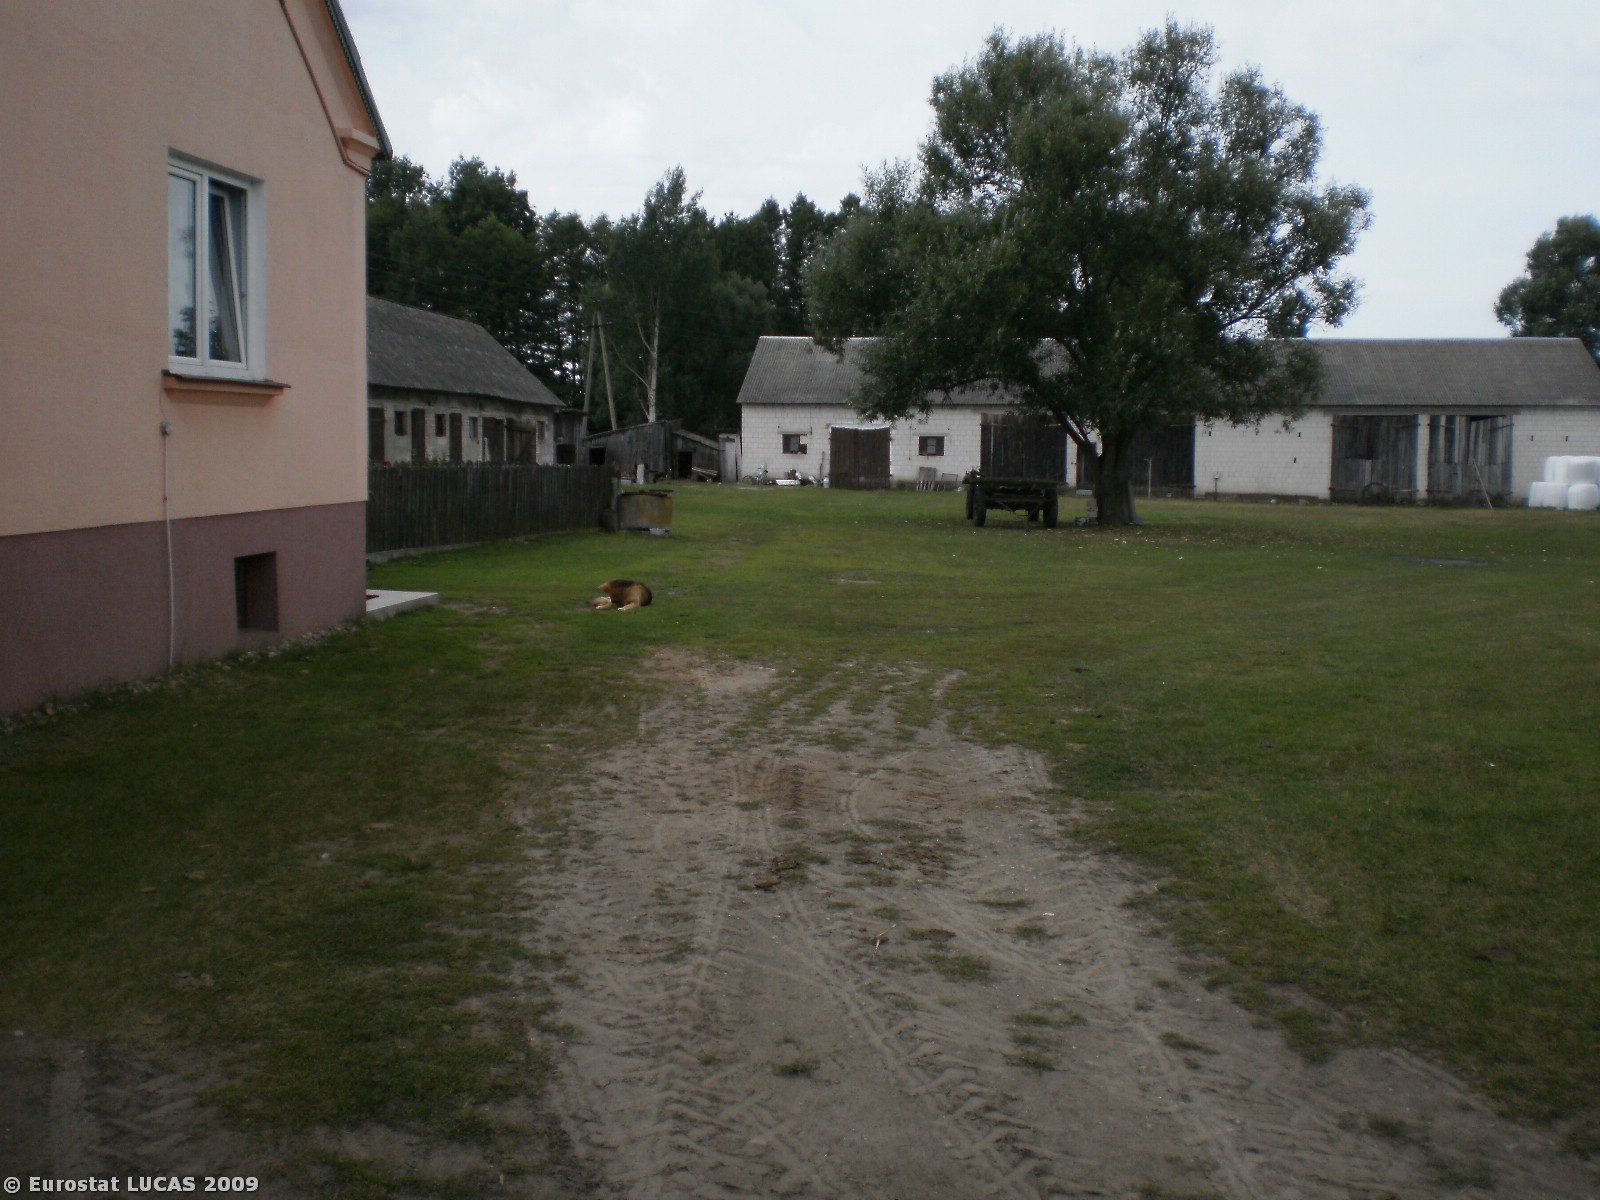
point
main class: Grassland
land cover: Grassland without tree/shrub cover
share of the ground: > 75 %
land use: Residential
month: August
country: PL
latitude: 52.9323
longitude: 21.7931
